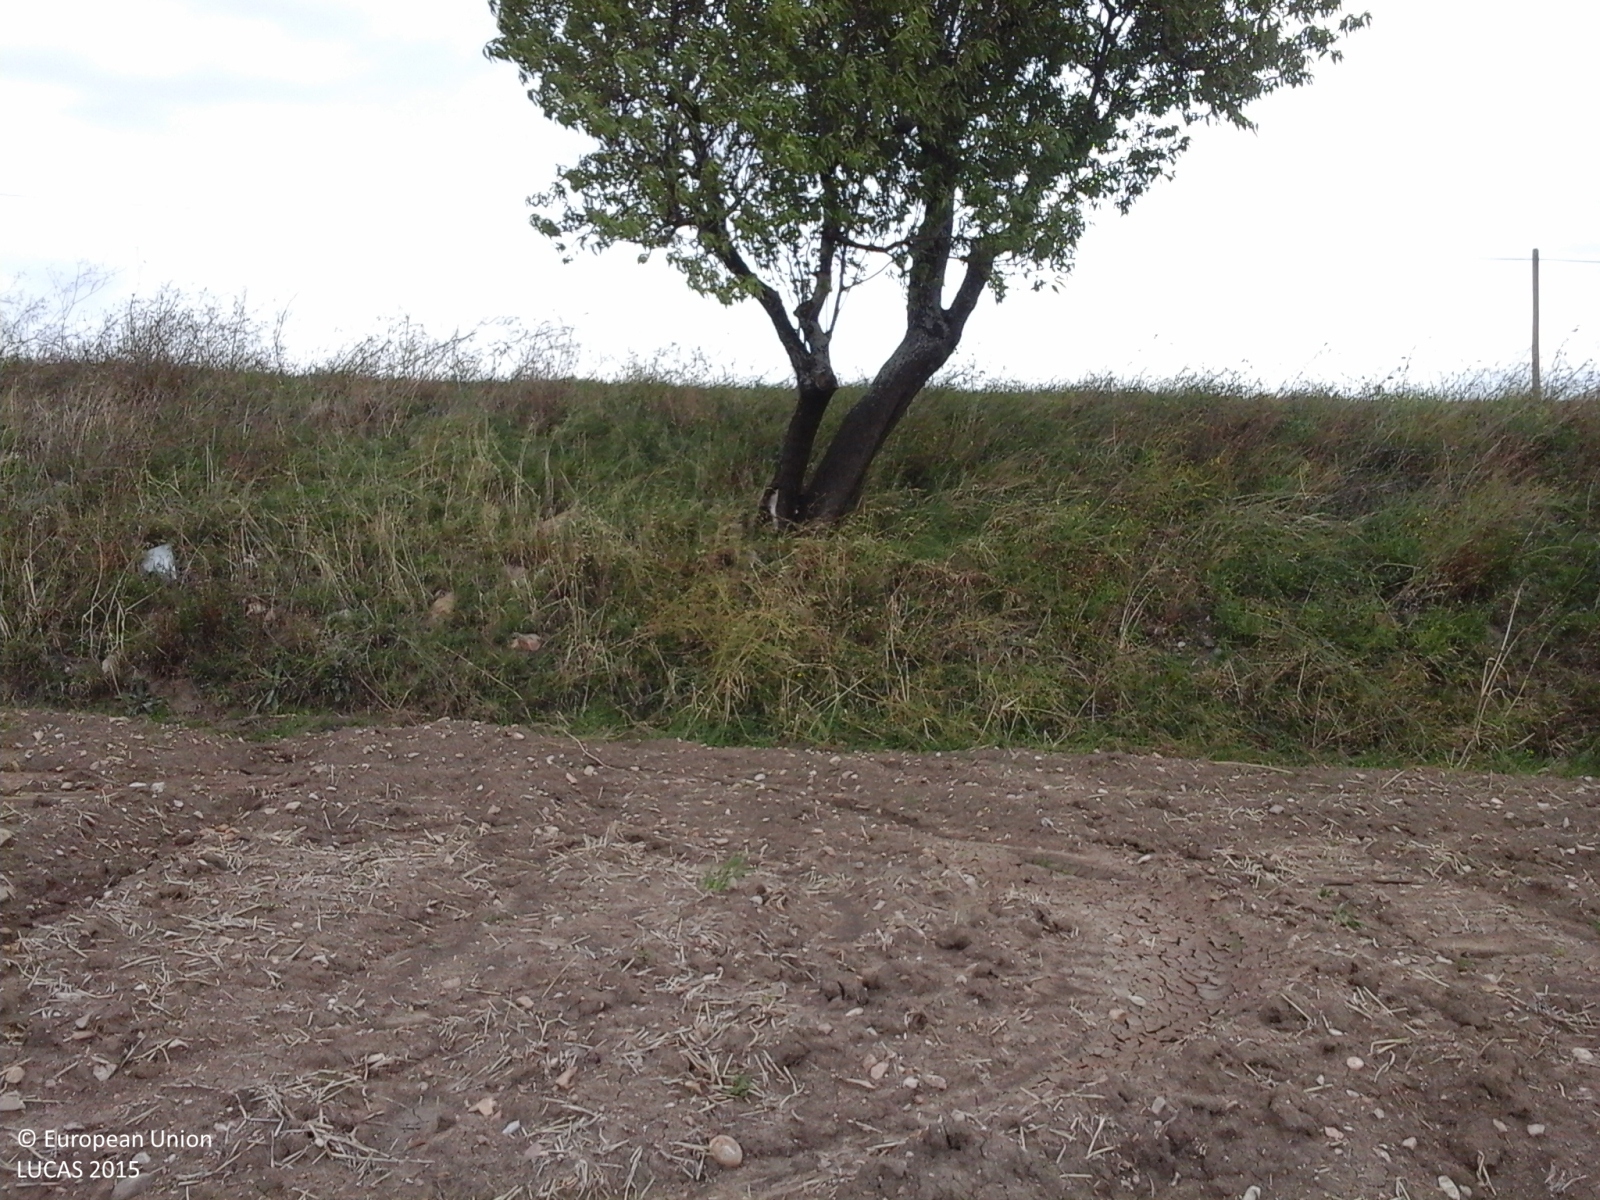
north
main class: Cropland
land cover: Barley
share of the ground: > 75 %
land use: Agriculture (excluding fallow land and kitchen gardens)
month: October
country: IT
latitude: 41.6009
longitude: 15.1303
